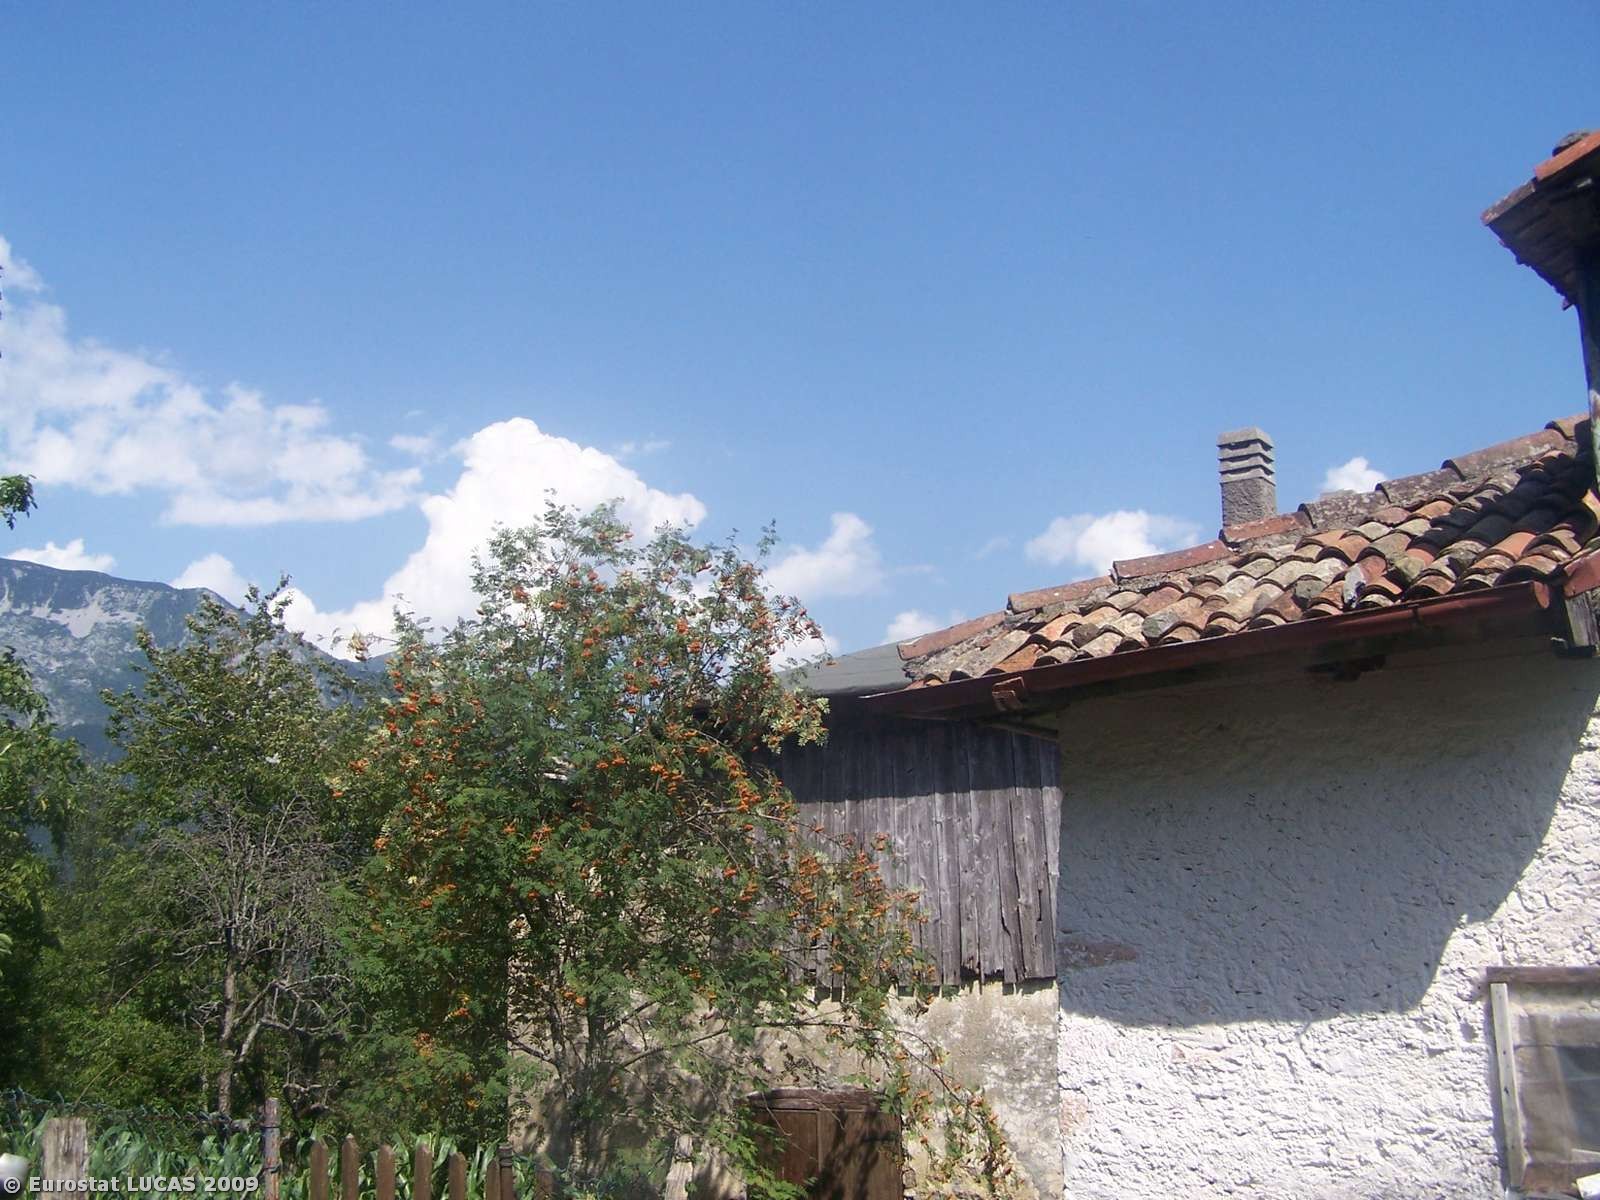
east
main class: Cropland
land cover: Nuts trees
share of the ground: 25 - 50 %
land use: Kitchen garden
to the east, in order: Nuts trees; Broadleaved woodland; Artificial constructions in urban areas; Grassland with sparse tree/shrub cover; Artificial constructions; Paved roads, cycling and walking lanes; Grassland with sparse tree/shrub cover; Artificial constructions; Tracks; Fences; Mixed woodland
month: July
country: IT
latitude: 46.4712
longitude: 13.0054
